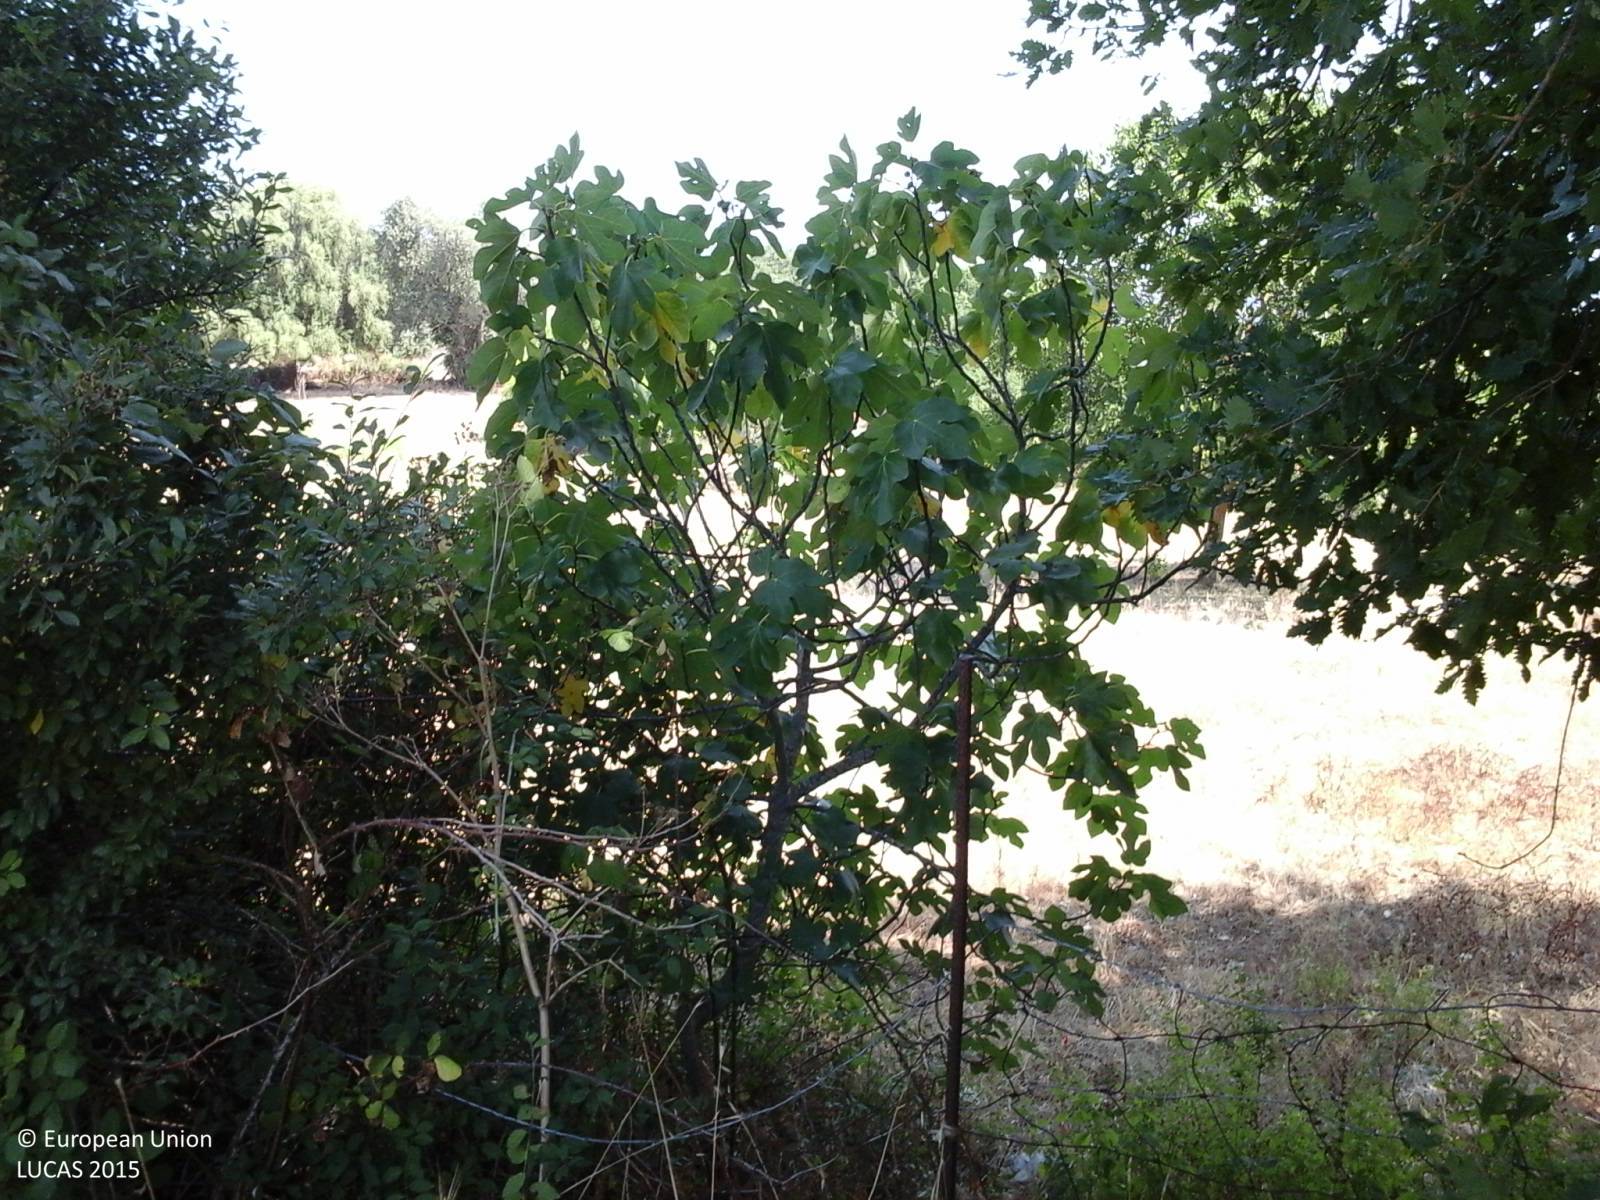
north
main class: Woodland
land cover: Broadleaved woodland
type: thermophilous deciduous forest
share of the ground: 25 - 50 %
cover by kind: broadleaved forest trees 90 %, herbaceous plants 10 %
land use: Semi-natural and natural areas not in use
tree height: > 5 m
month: July
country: IT
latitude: 40.7850
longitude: 8.8088
